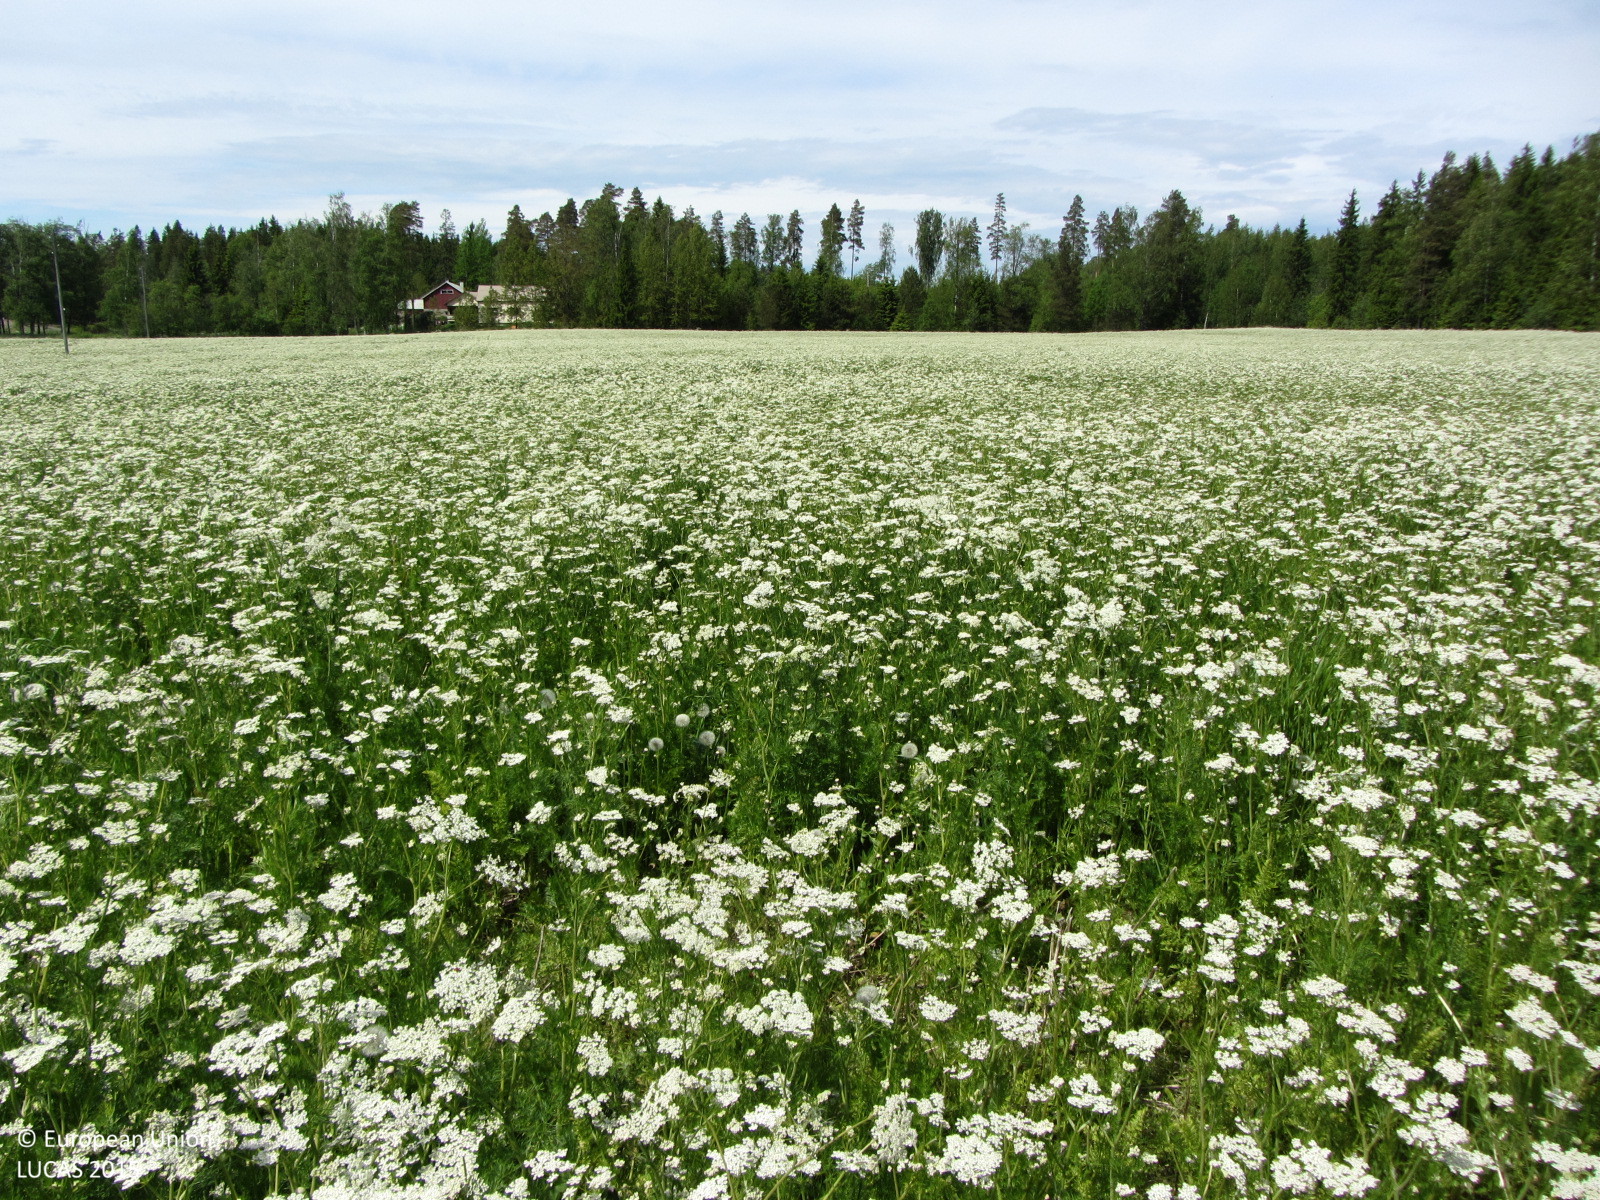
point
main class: Cropland
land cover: Other non-permanent industrial crops
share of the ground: > 75 %
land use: Agriculture (excluding fallow land and kitchen gardens)
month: June
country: FI
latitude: 60.3919
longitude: 24.3849
